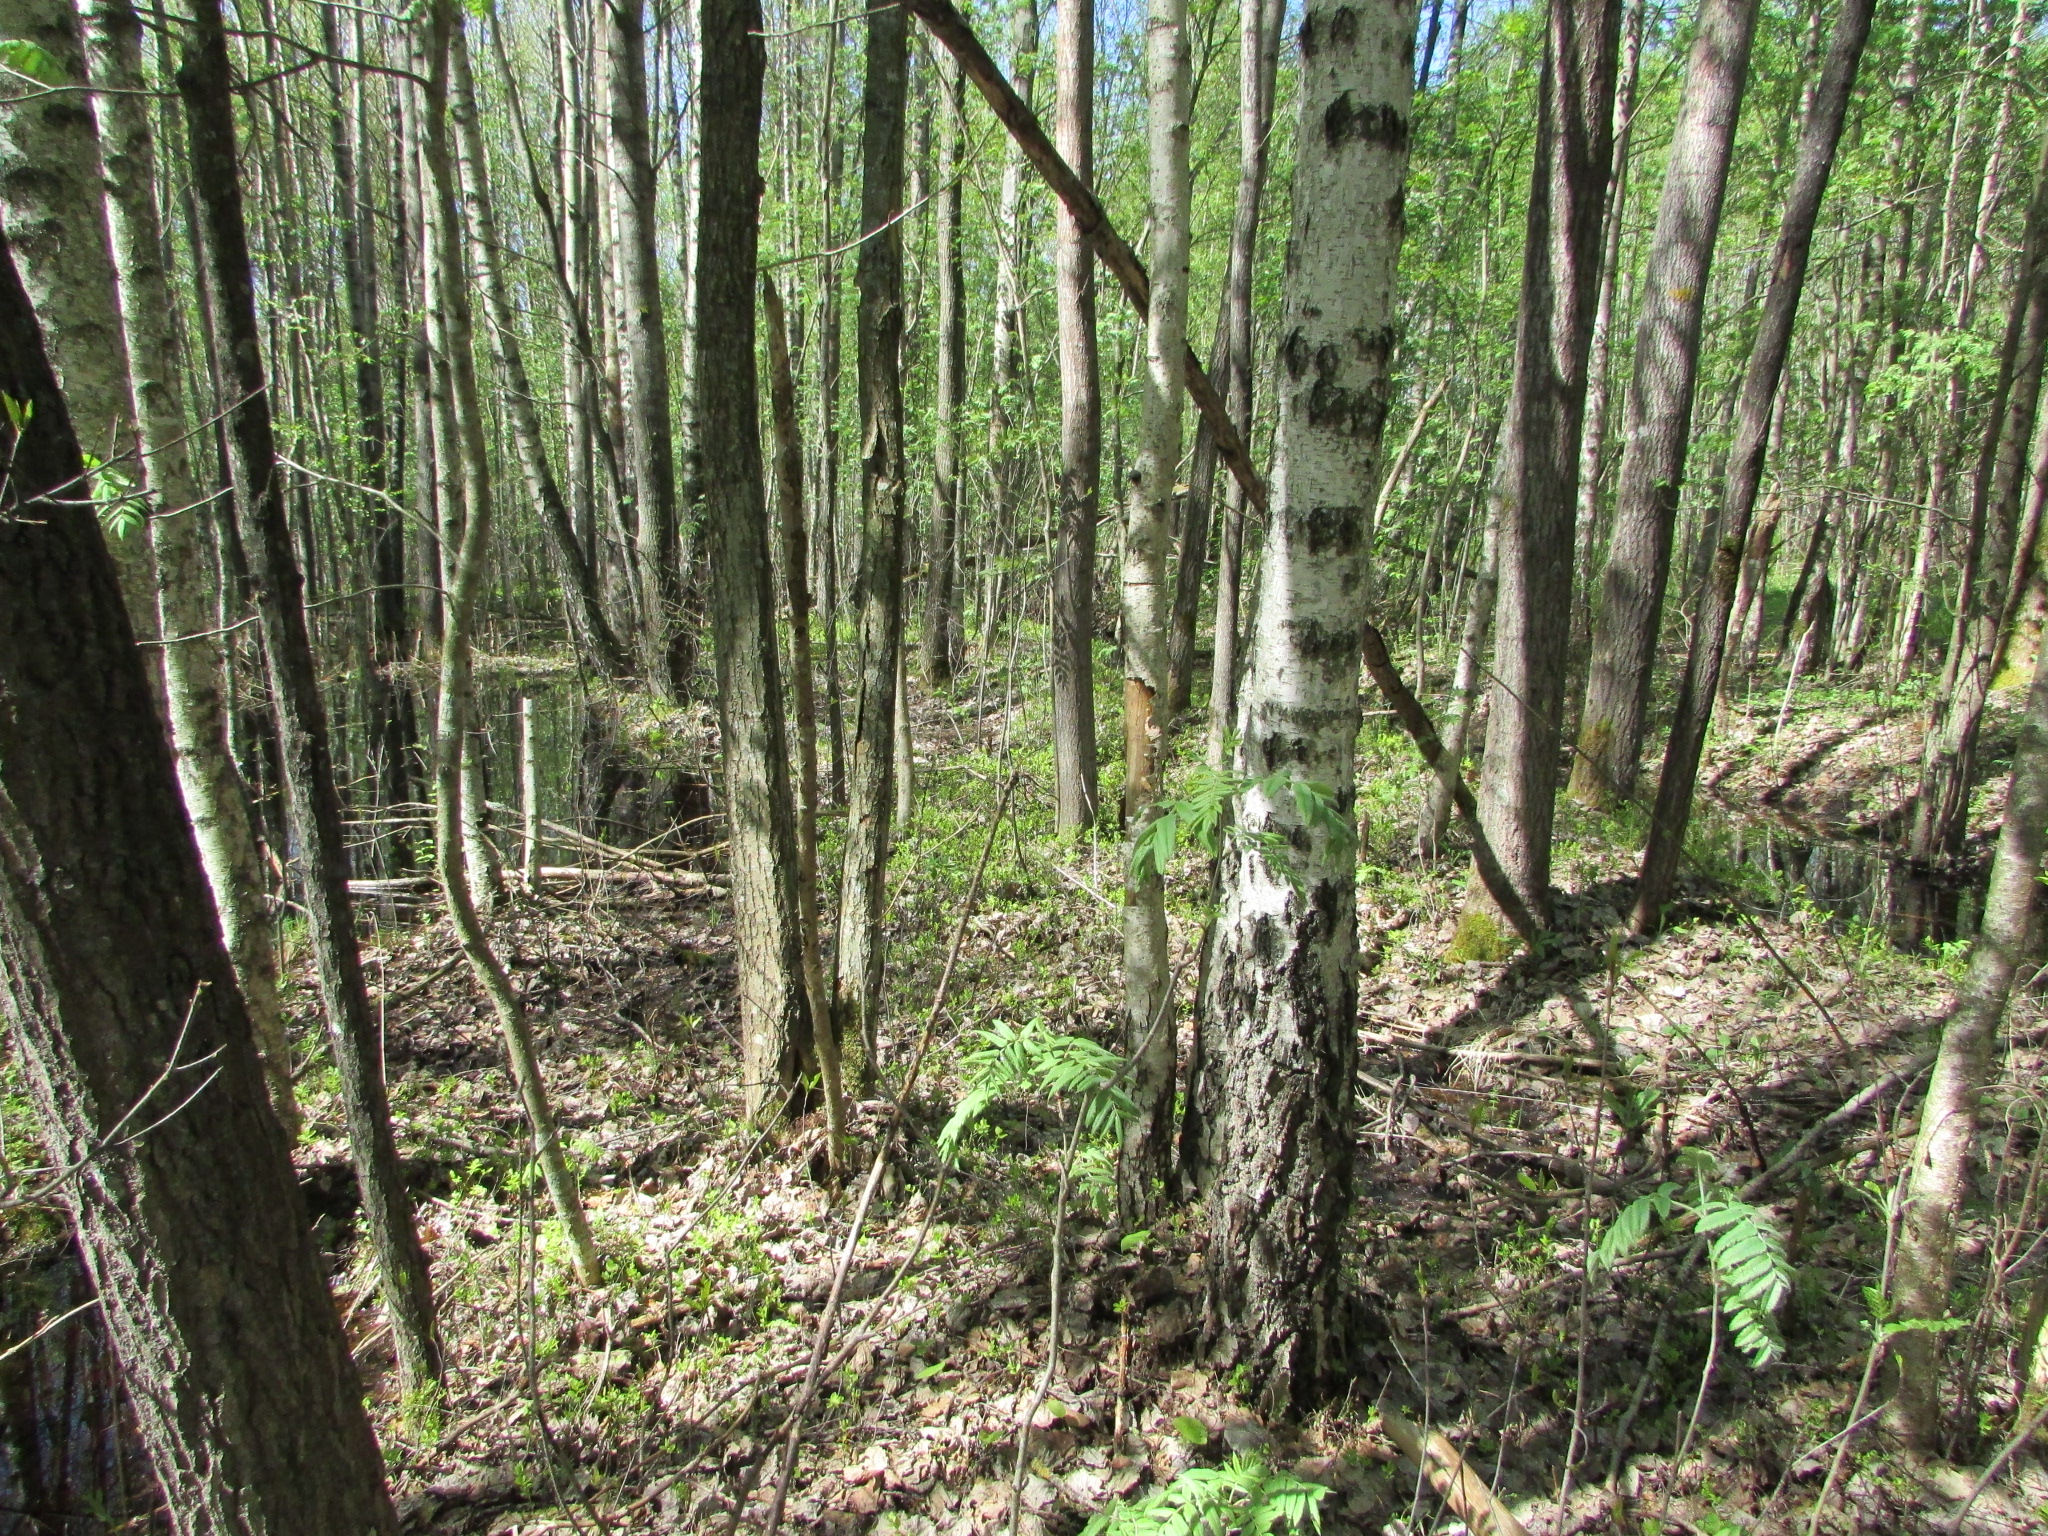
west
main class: Woodland
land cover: Broadleaved woodland
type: floodplain forest
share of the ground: > 75 %
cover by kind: broadleaved forest trees 100 %
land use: Forestry
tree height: > 5 m
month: May
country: LV
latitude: 56.0486
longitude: 27.0402
